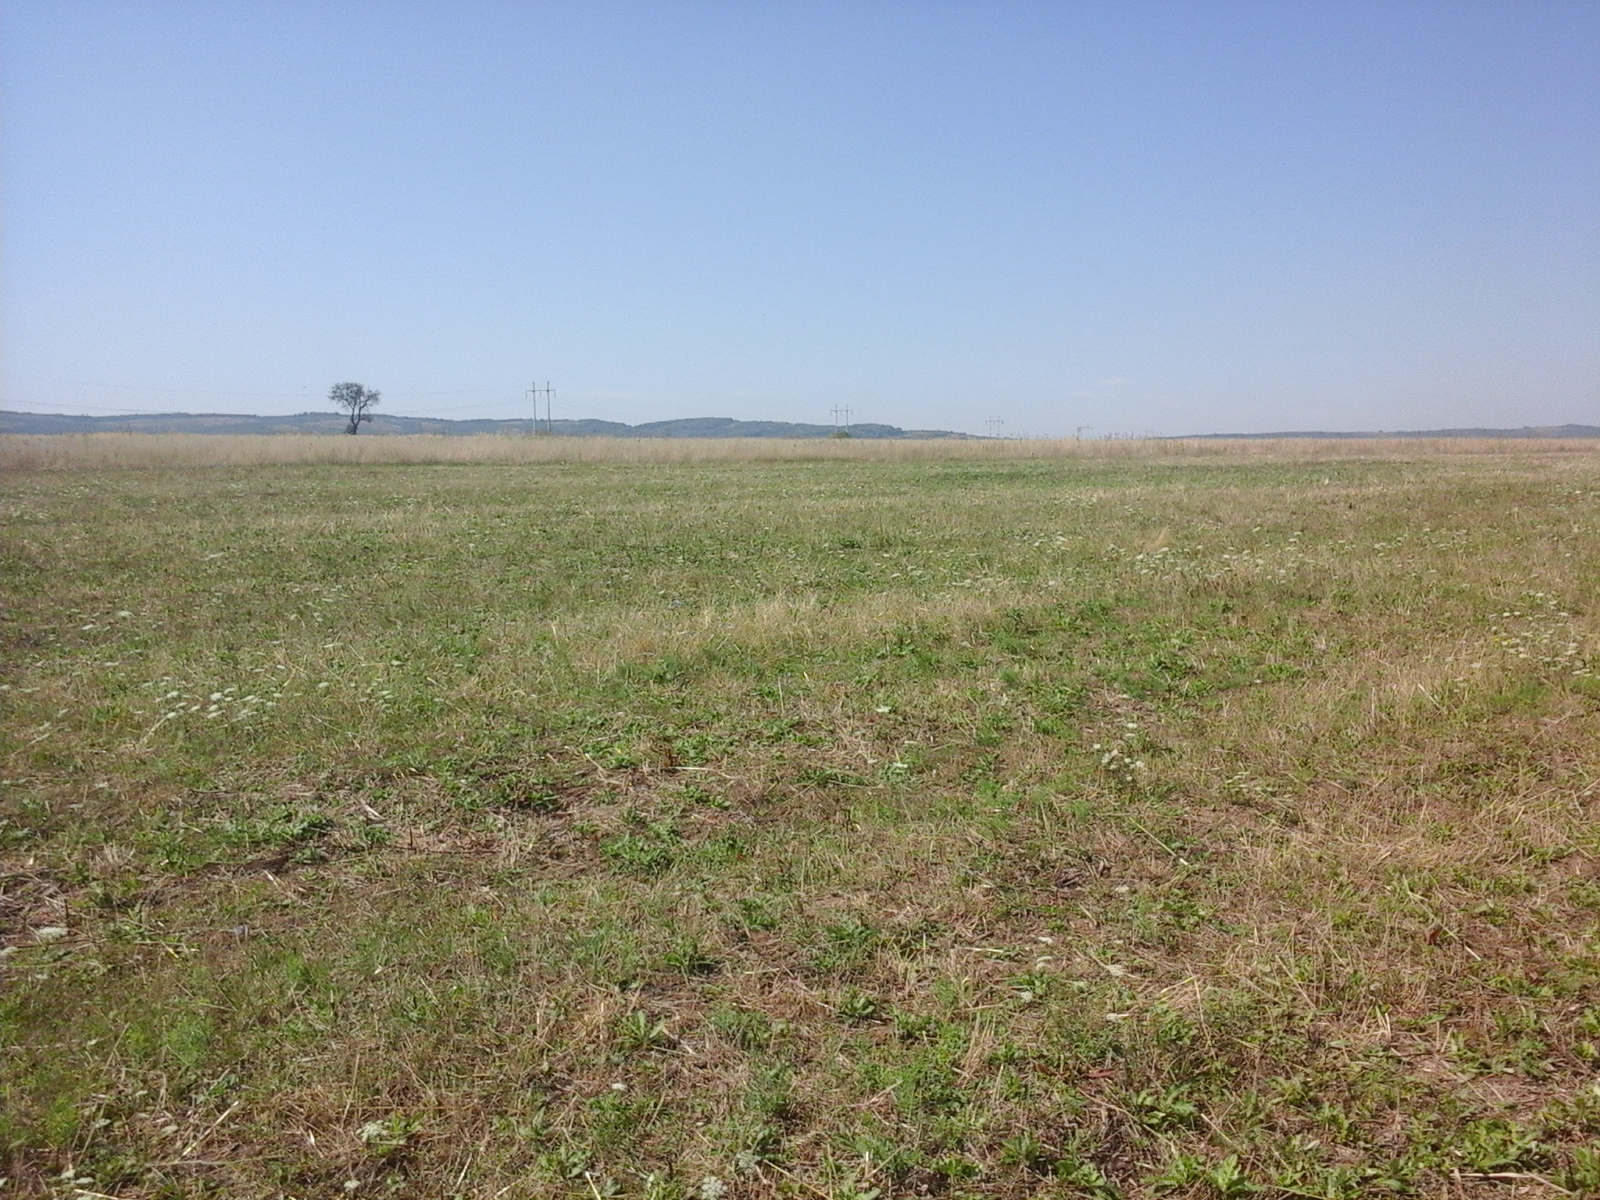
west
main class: Cropland
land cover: Common wheat
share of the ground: 25 - 50 %
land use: Agriculture (excluding fallow land and kitchen gardens)
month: August
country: RO
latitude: 45.6109
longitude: 21.7431
